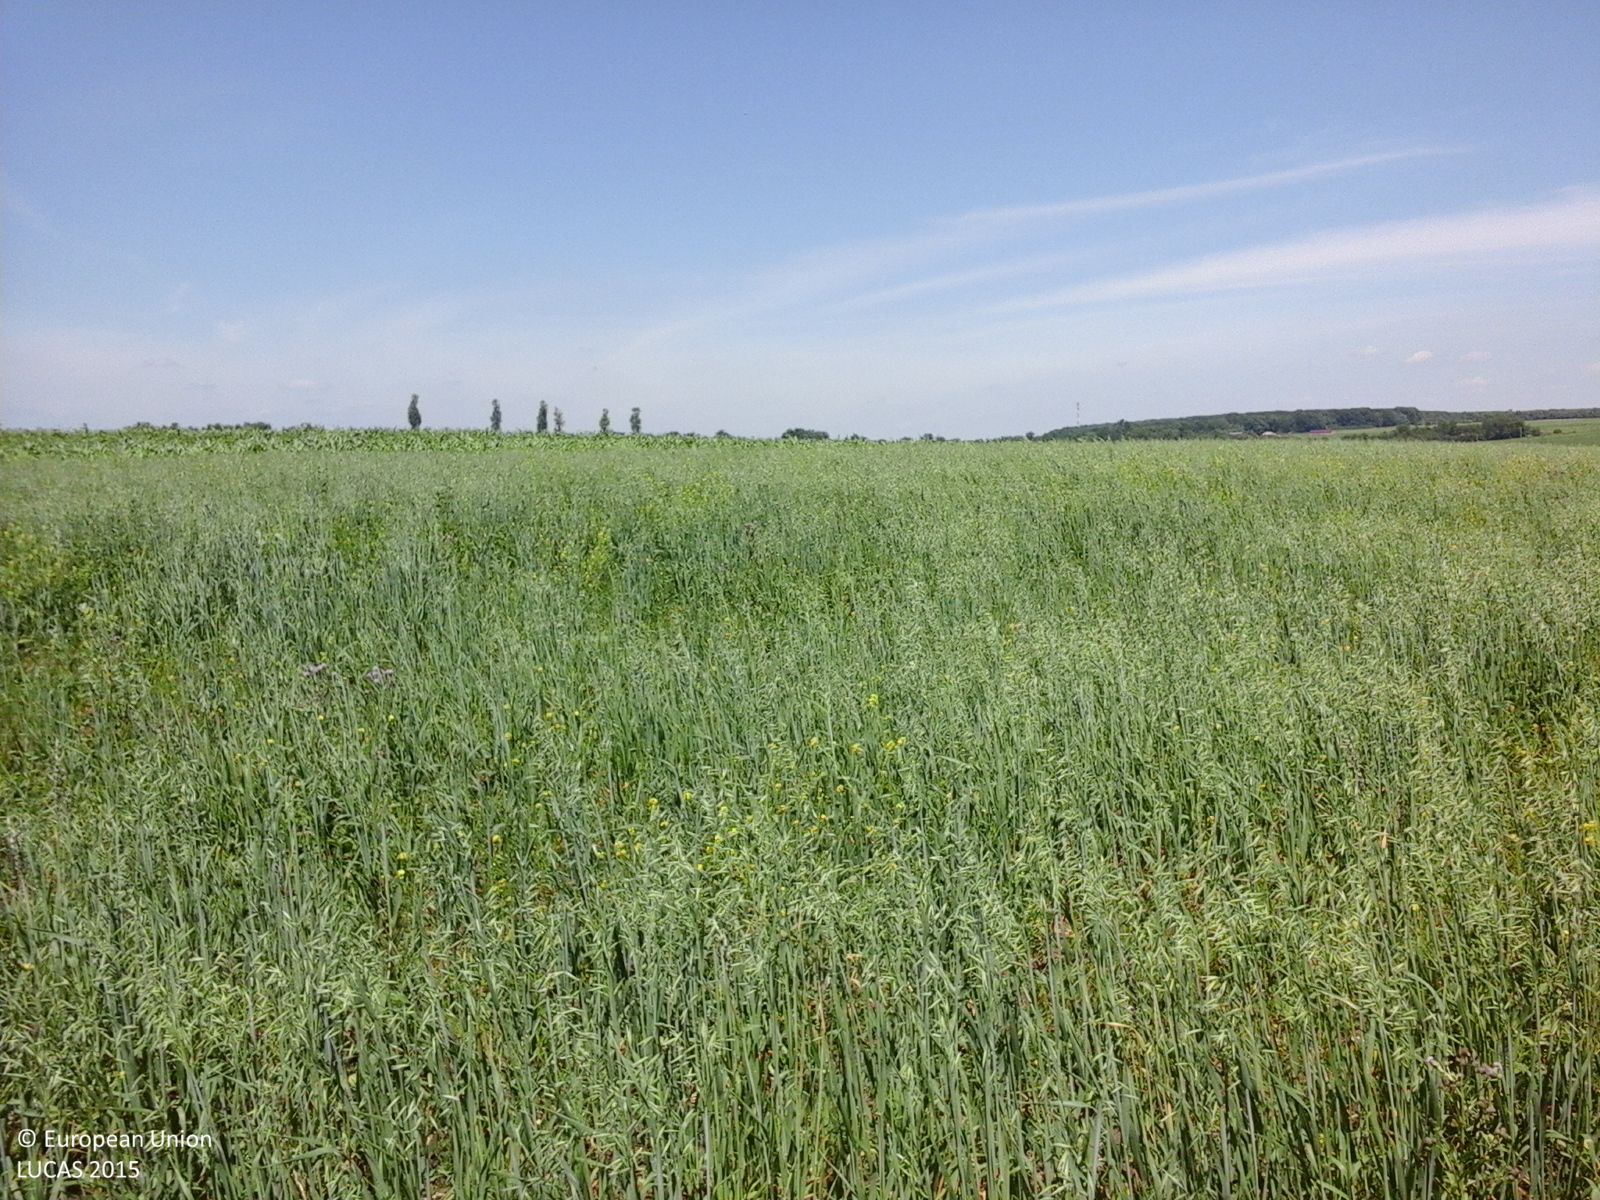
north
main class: Cropland
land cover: Oats
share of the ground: > 75 %
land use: Agriculture (excluding fallow land and kitchen gardens)
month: June
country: RO
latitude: 47.9494
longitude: 27.0452
